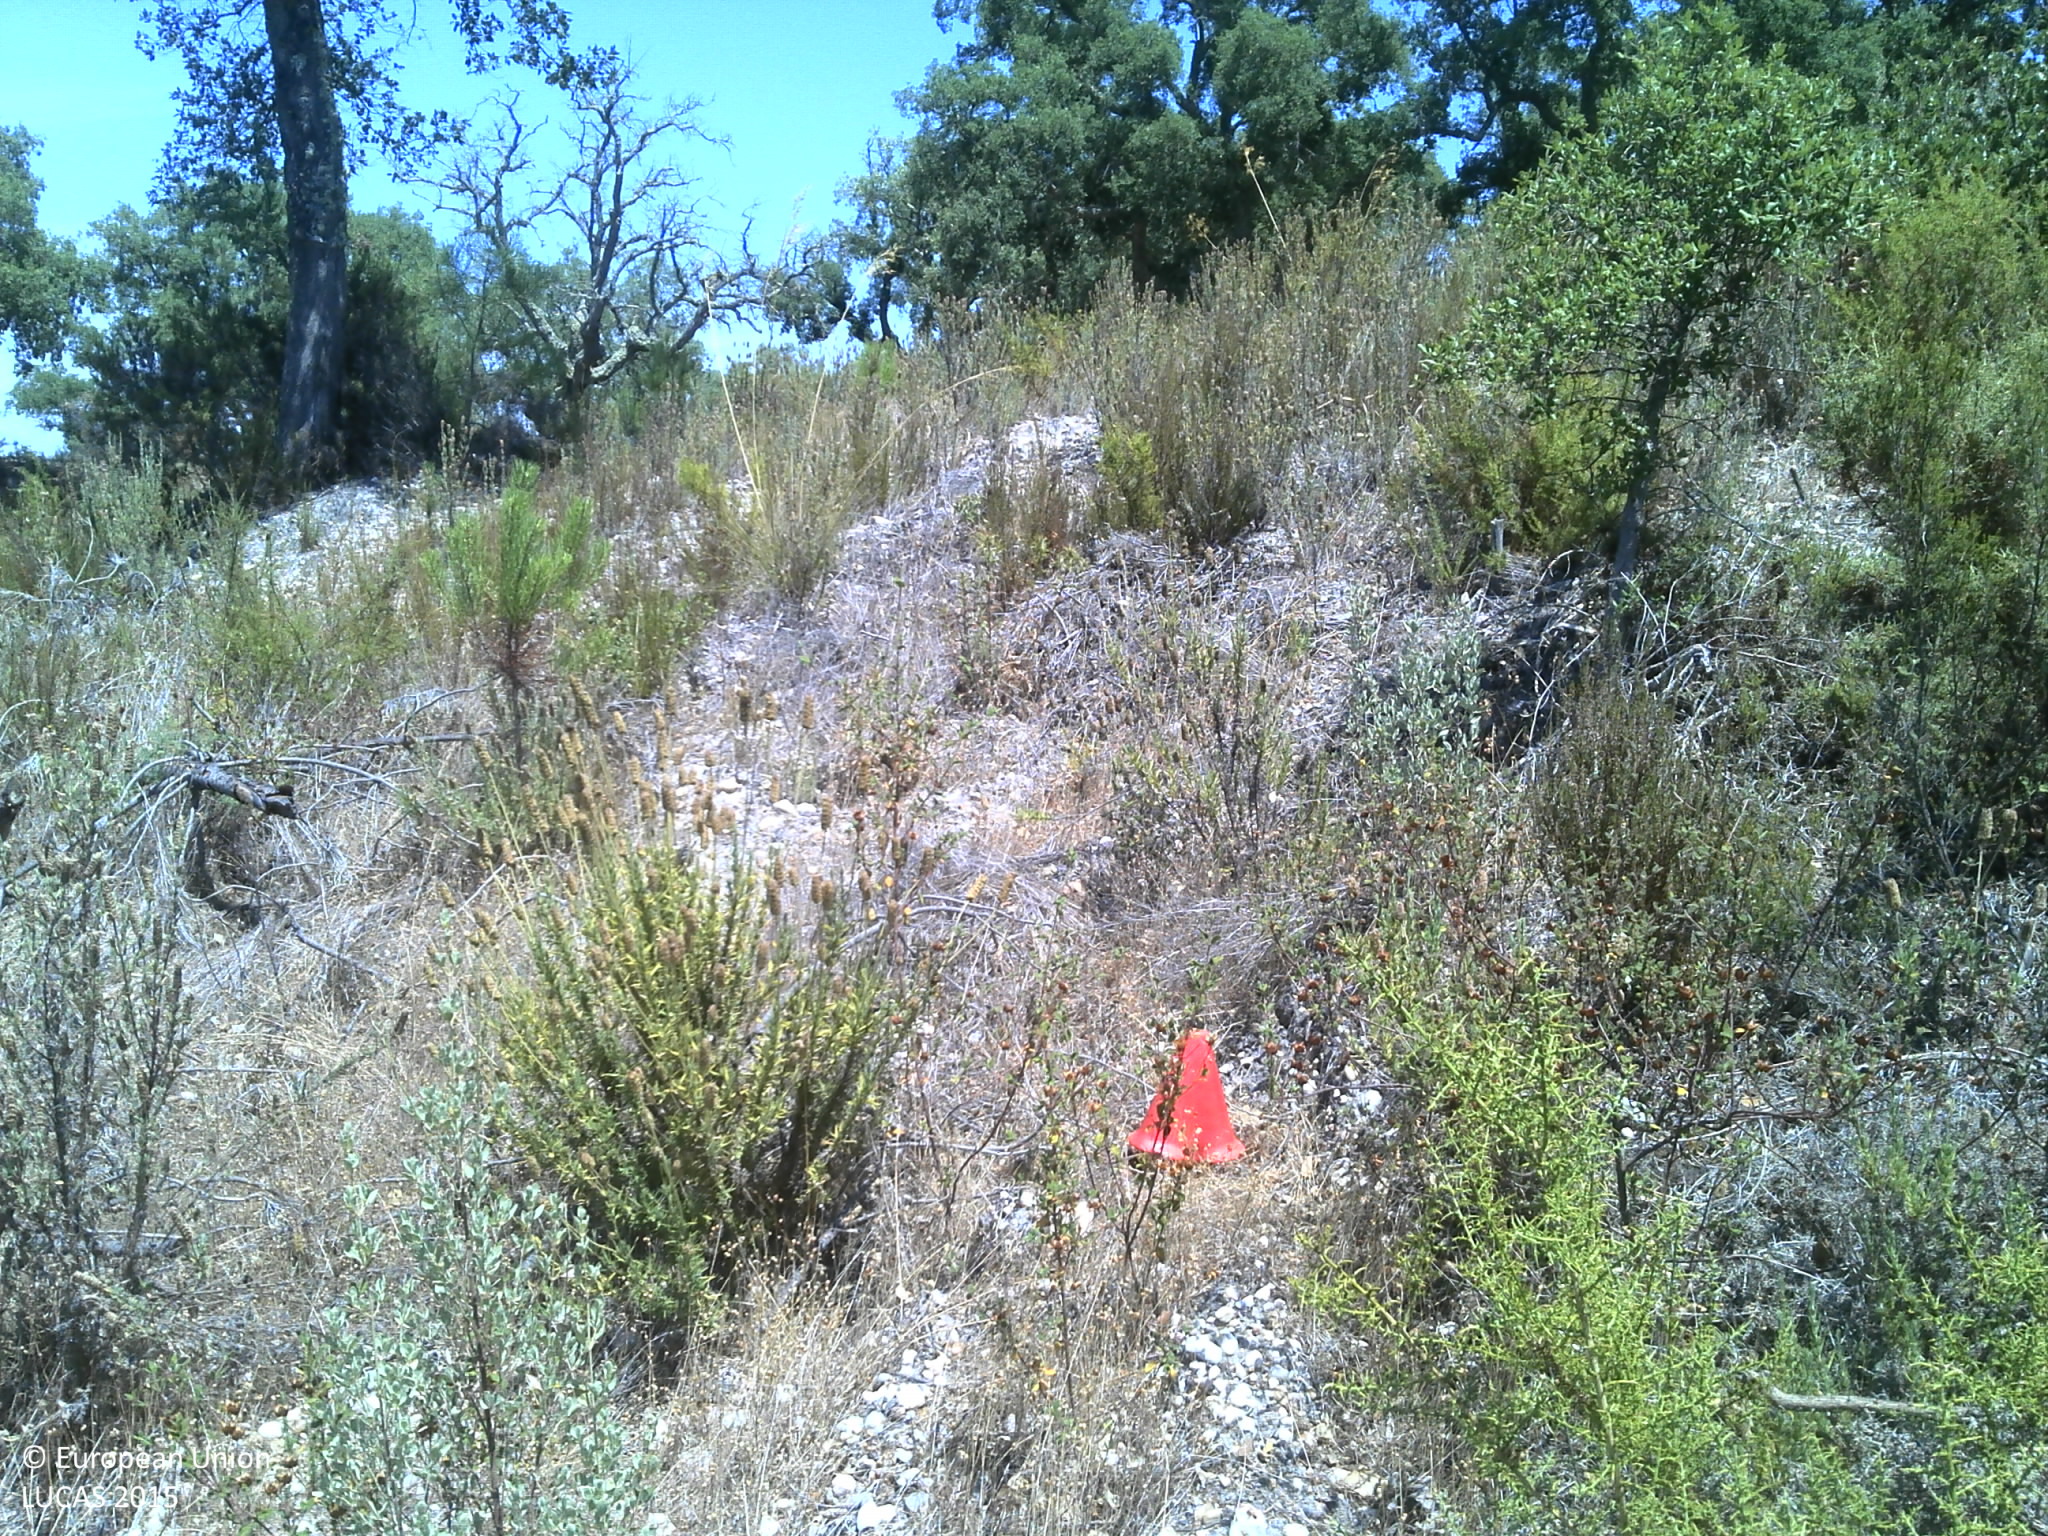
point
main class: Grassland
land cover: Grassland with sparse tree/shrub cover
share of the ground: 25 - 50 %
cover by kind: herbaceous plants 45 %, unconsolidated bare surface 40 %, shrubs 10 %, broadleaved forest trees 5 %
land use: Forestry
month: July
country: PT
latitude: 39.2176
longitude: -8.2801
